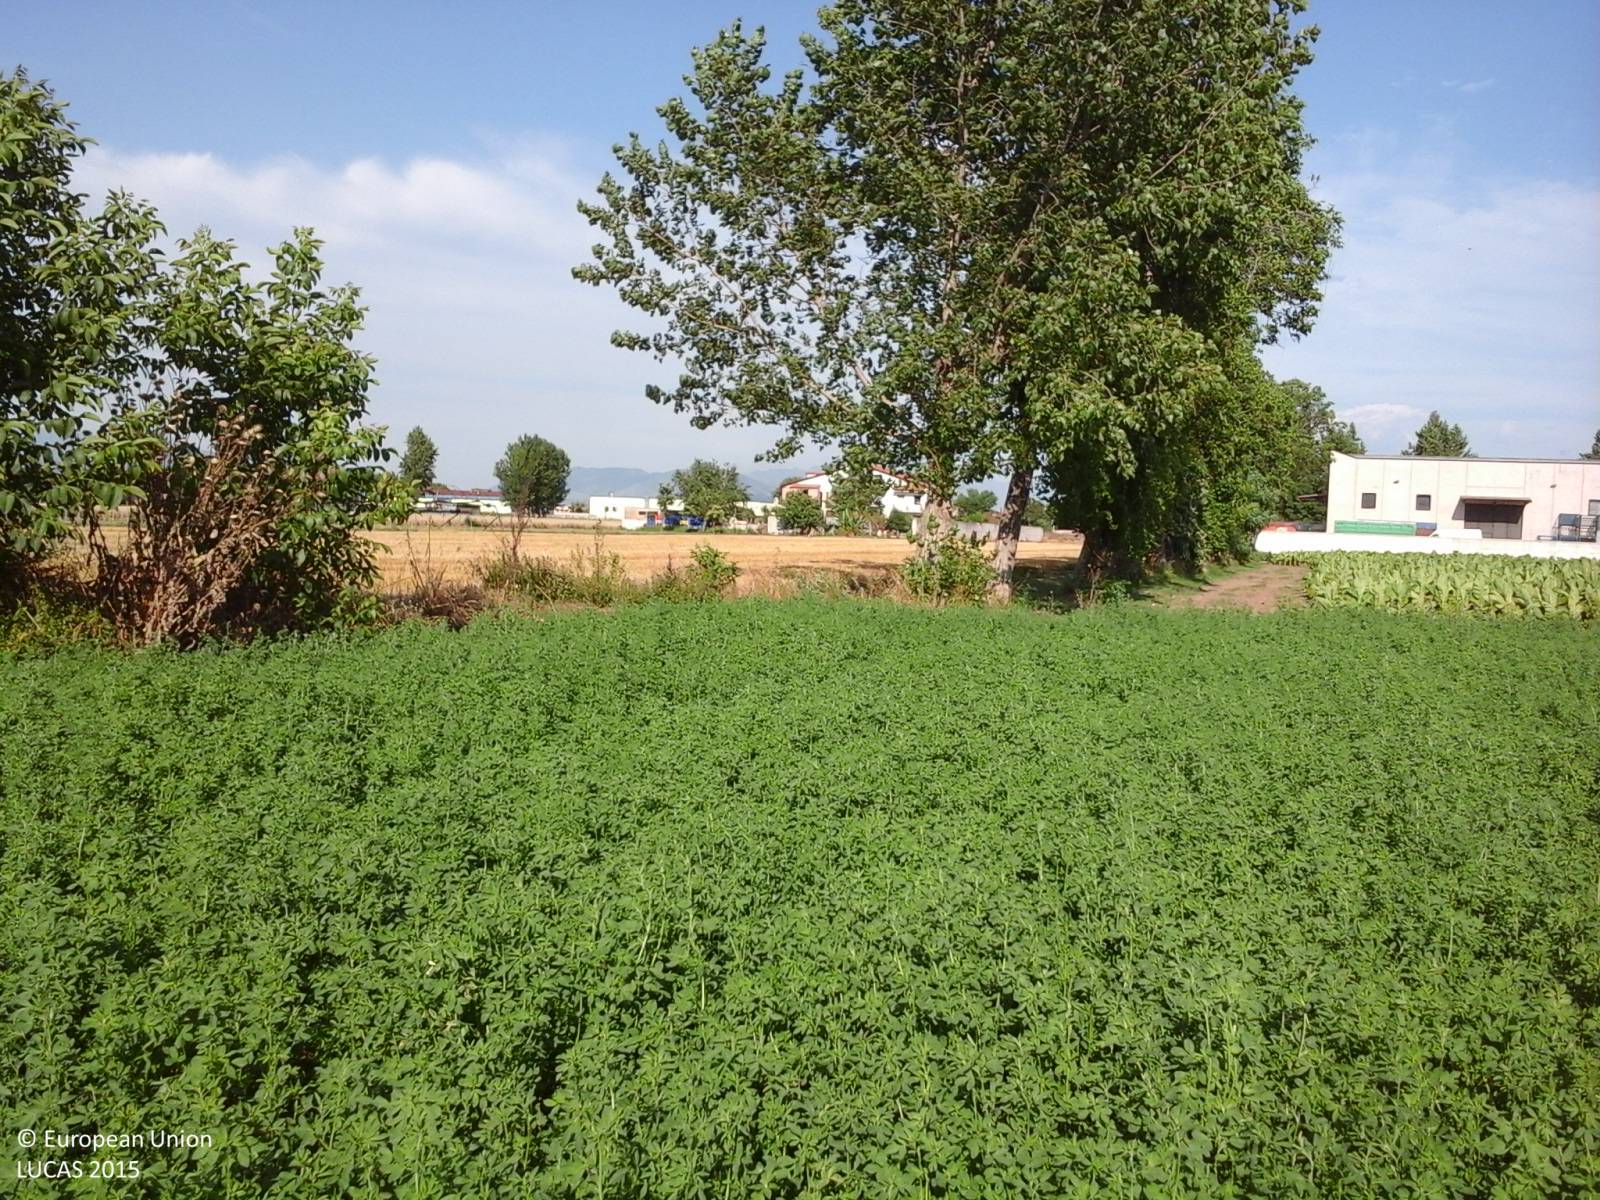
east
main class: Cropland
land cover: Lucerne
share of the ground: > 75 %
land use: Agriculture (excluding fallow land and kitchen gardens)
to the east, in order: Lucerne; Grass margins; Durum wheat; Grass margins; Tracks; Other fresh vegetables; Lines of trees; Artificial constructions in urban areas
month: June
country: IT
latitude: 40.9895
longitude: 14.2737
